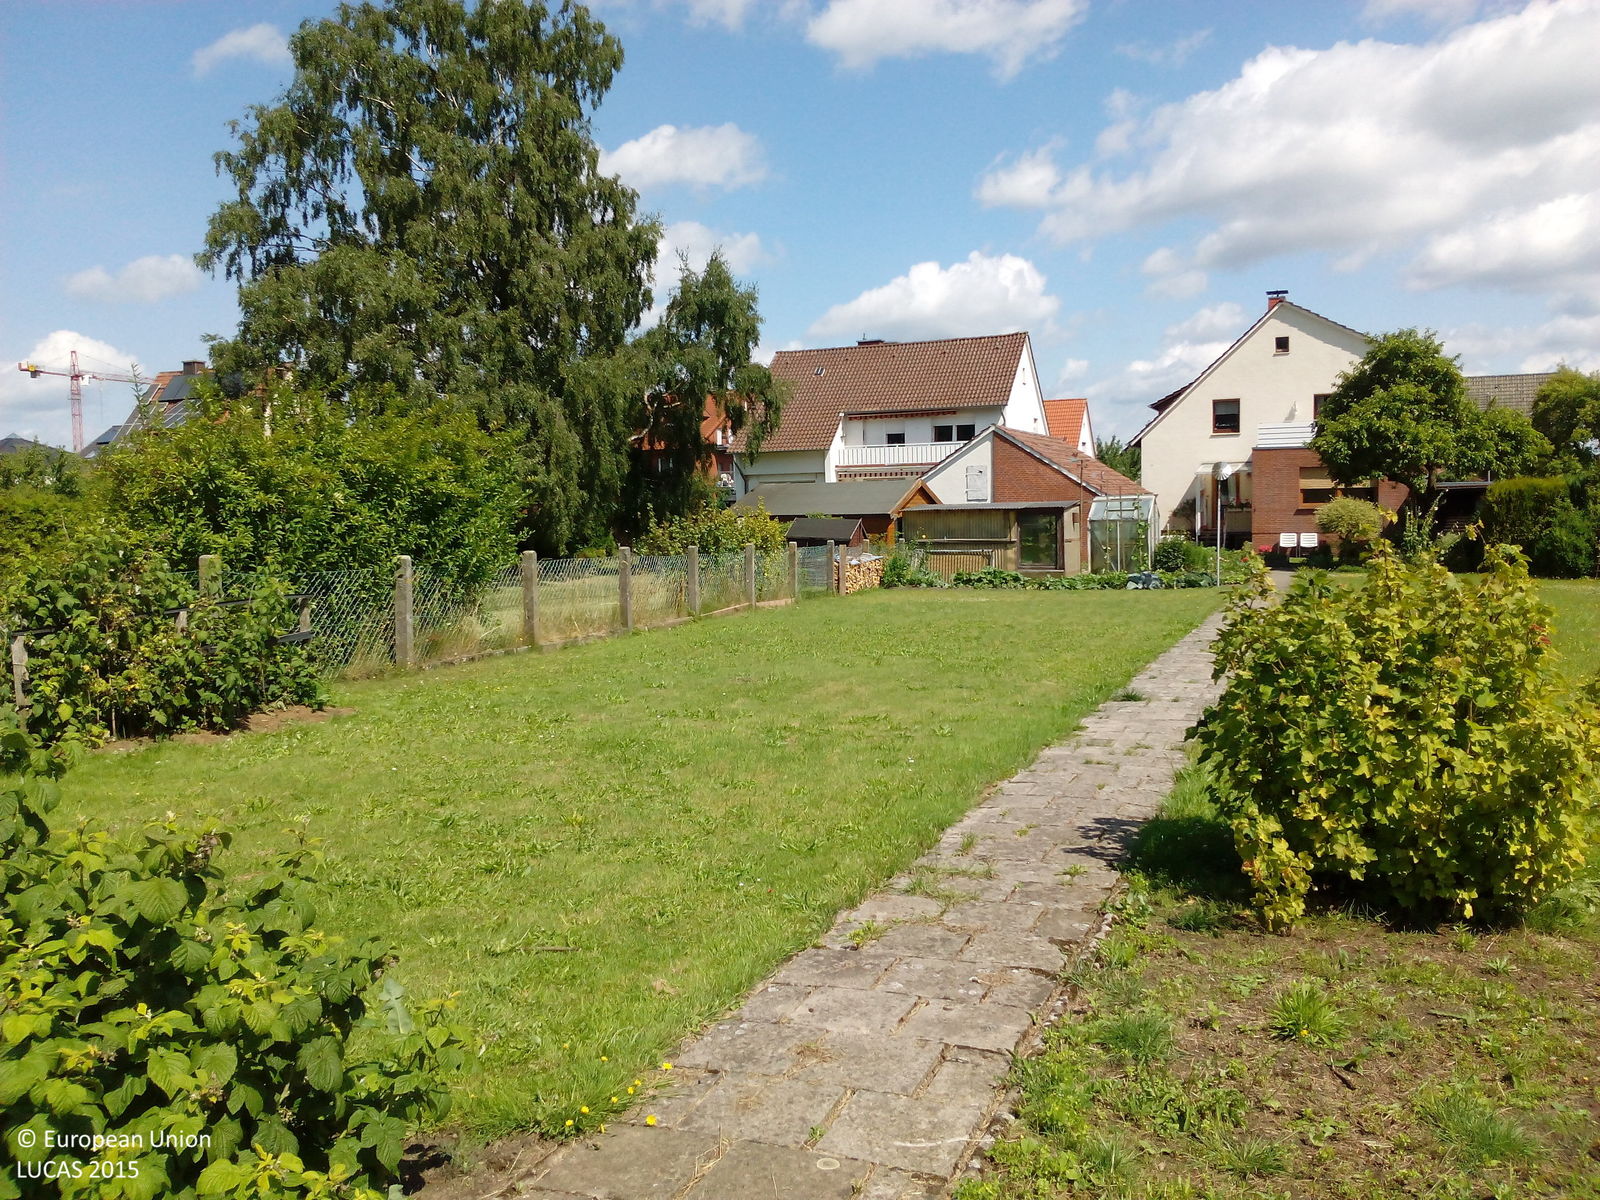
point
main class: Grassland
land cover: Grassland without tree/shrub cover
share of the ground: > 75 %
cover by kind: herbaceous plants 100 %
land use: Residential
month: July
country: DE
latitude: 52.2342
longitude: 7.9651
